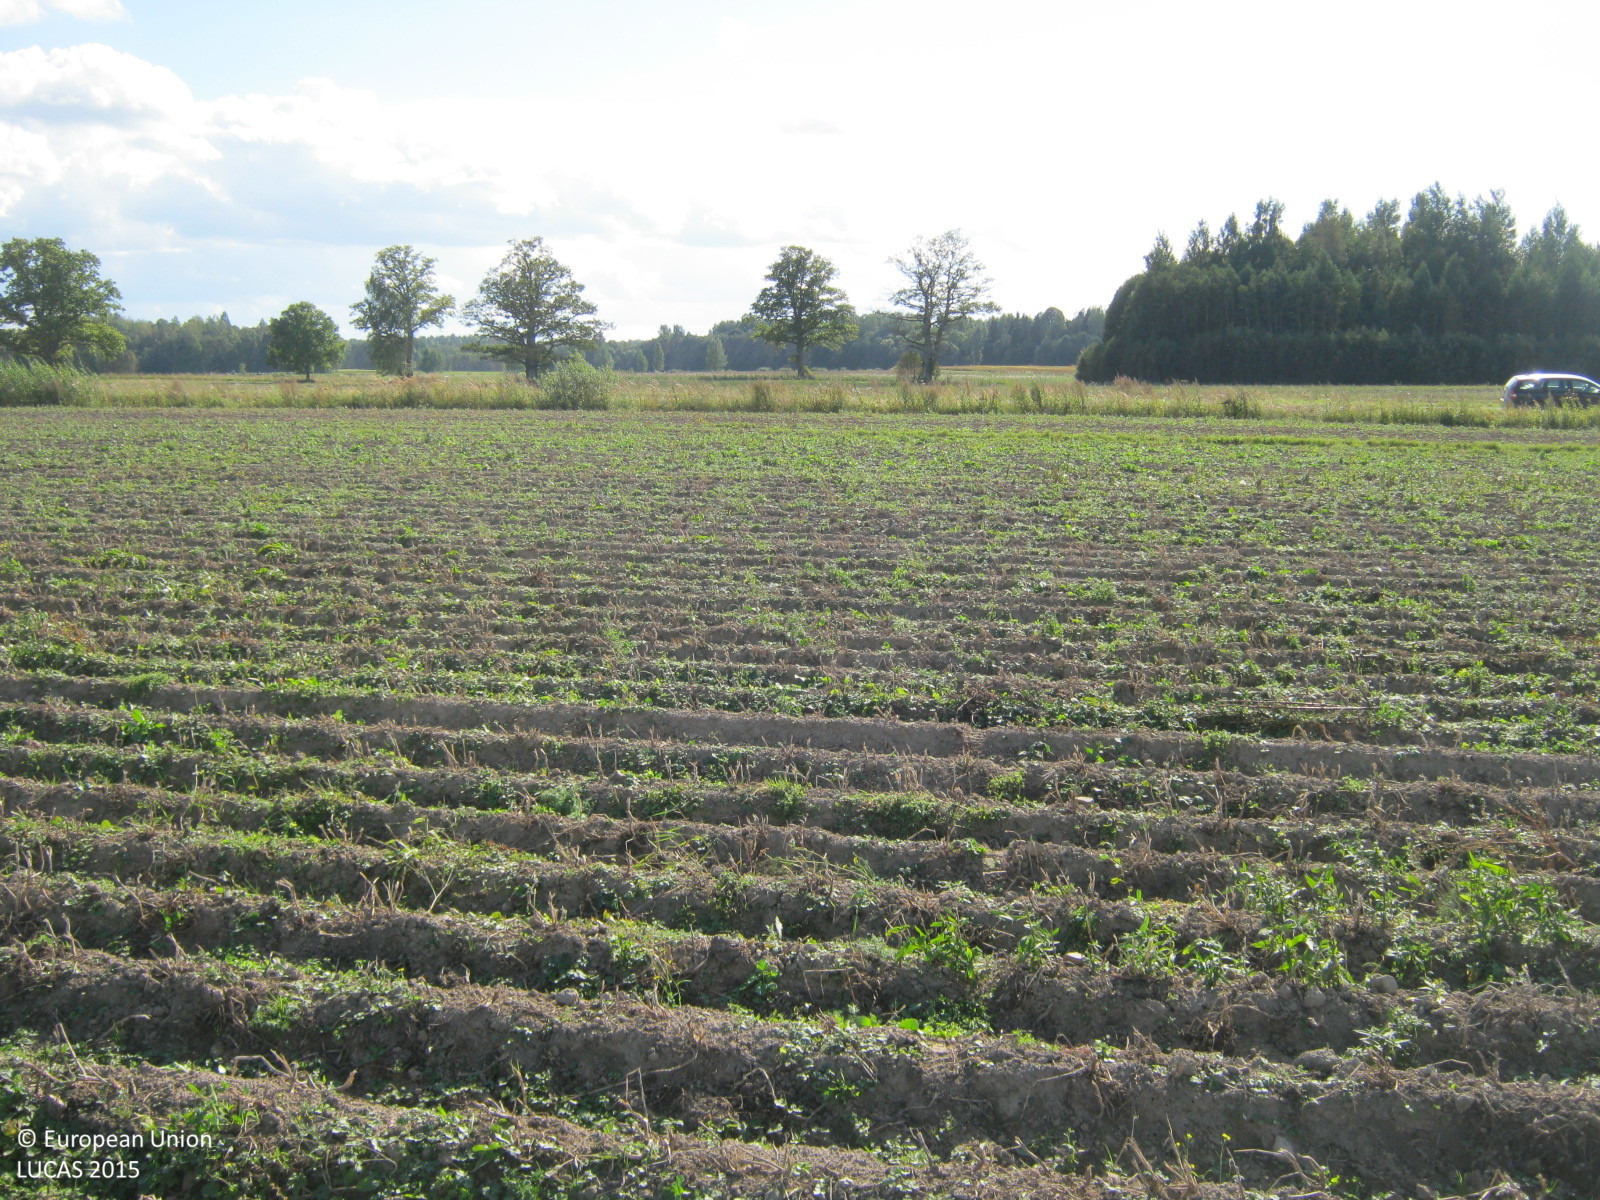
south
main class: Cropland
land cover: Potatoes
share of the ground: < 10 %
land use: Agriculture (excluding fallow land and kitchen gardens)
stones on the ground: < 10 %
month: September
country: LV
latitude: 57.3390
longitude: 24.6322
